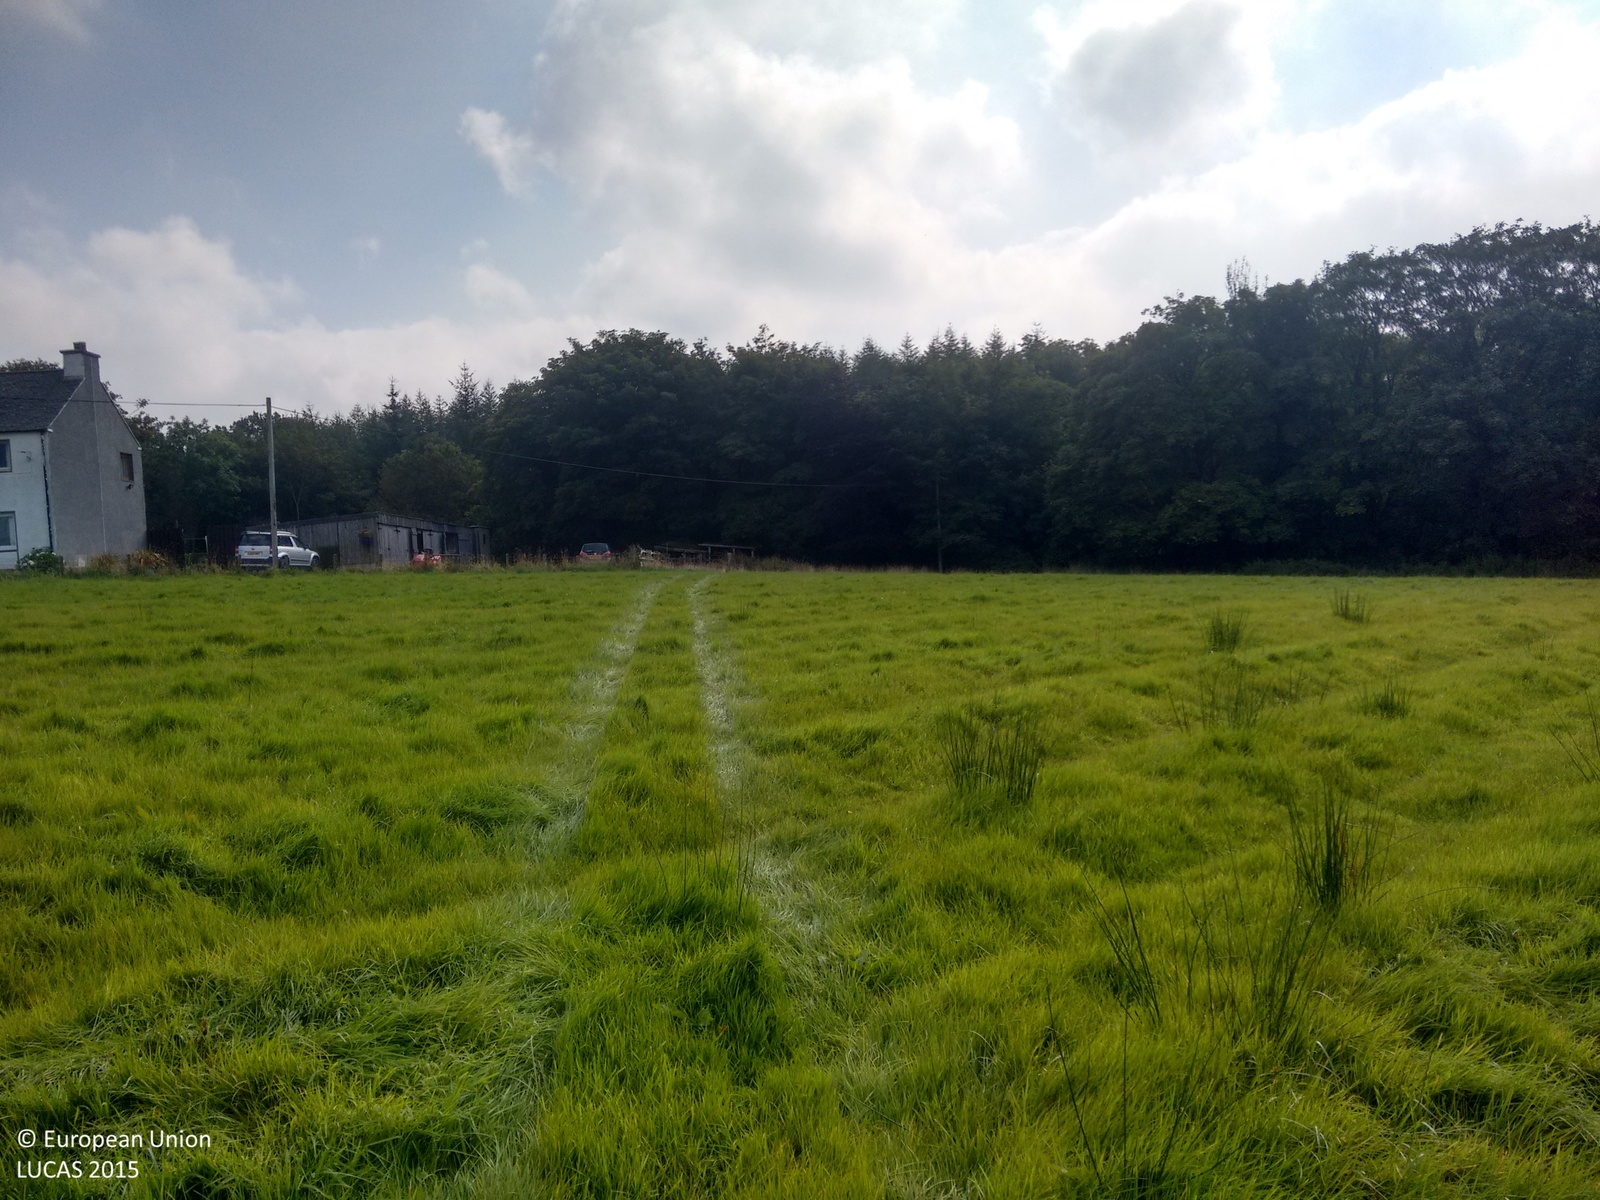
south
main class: Grassland
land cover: Grassland without tree/shrub cover
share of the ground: > 75 %
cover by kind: herbaceous plants 100 %
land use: Agriculture (excluding fallow land and kitchen gardens)
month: September
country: GB
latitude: 55.0814
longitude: -4.9786
